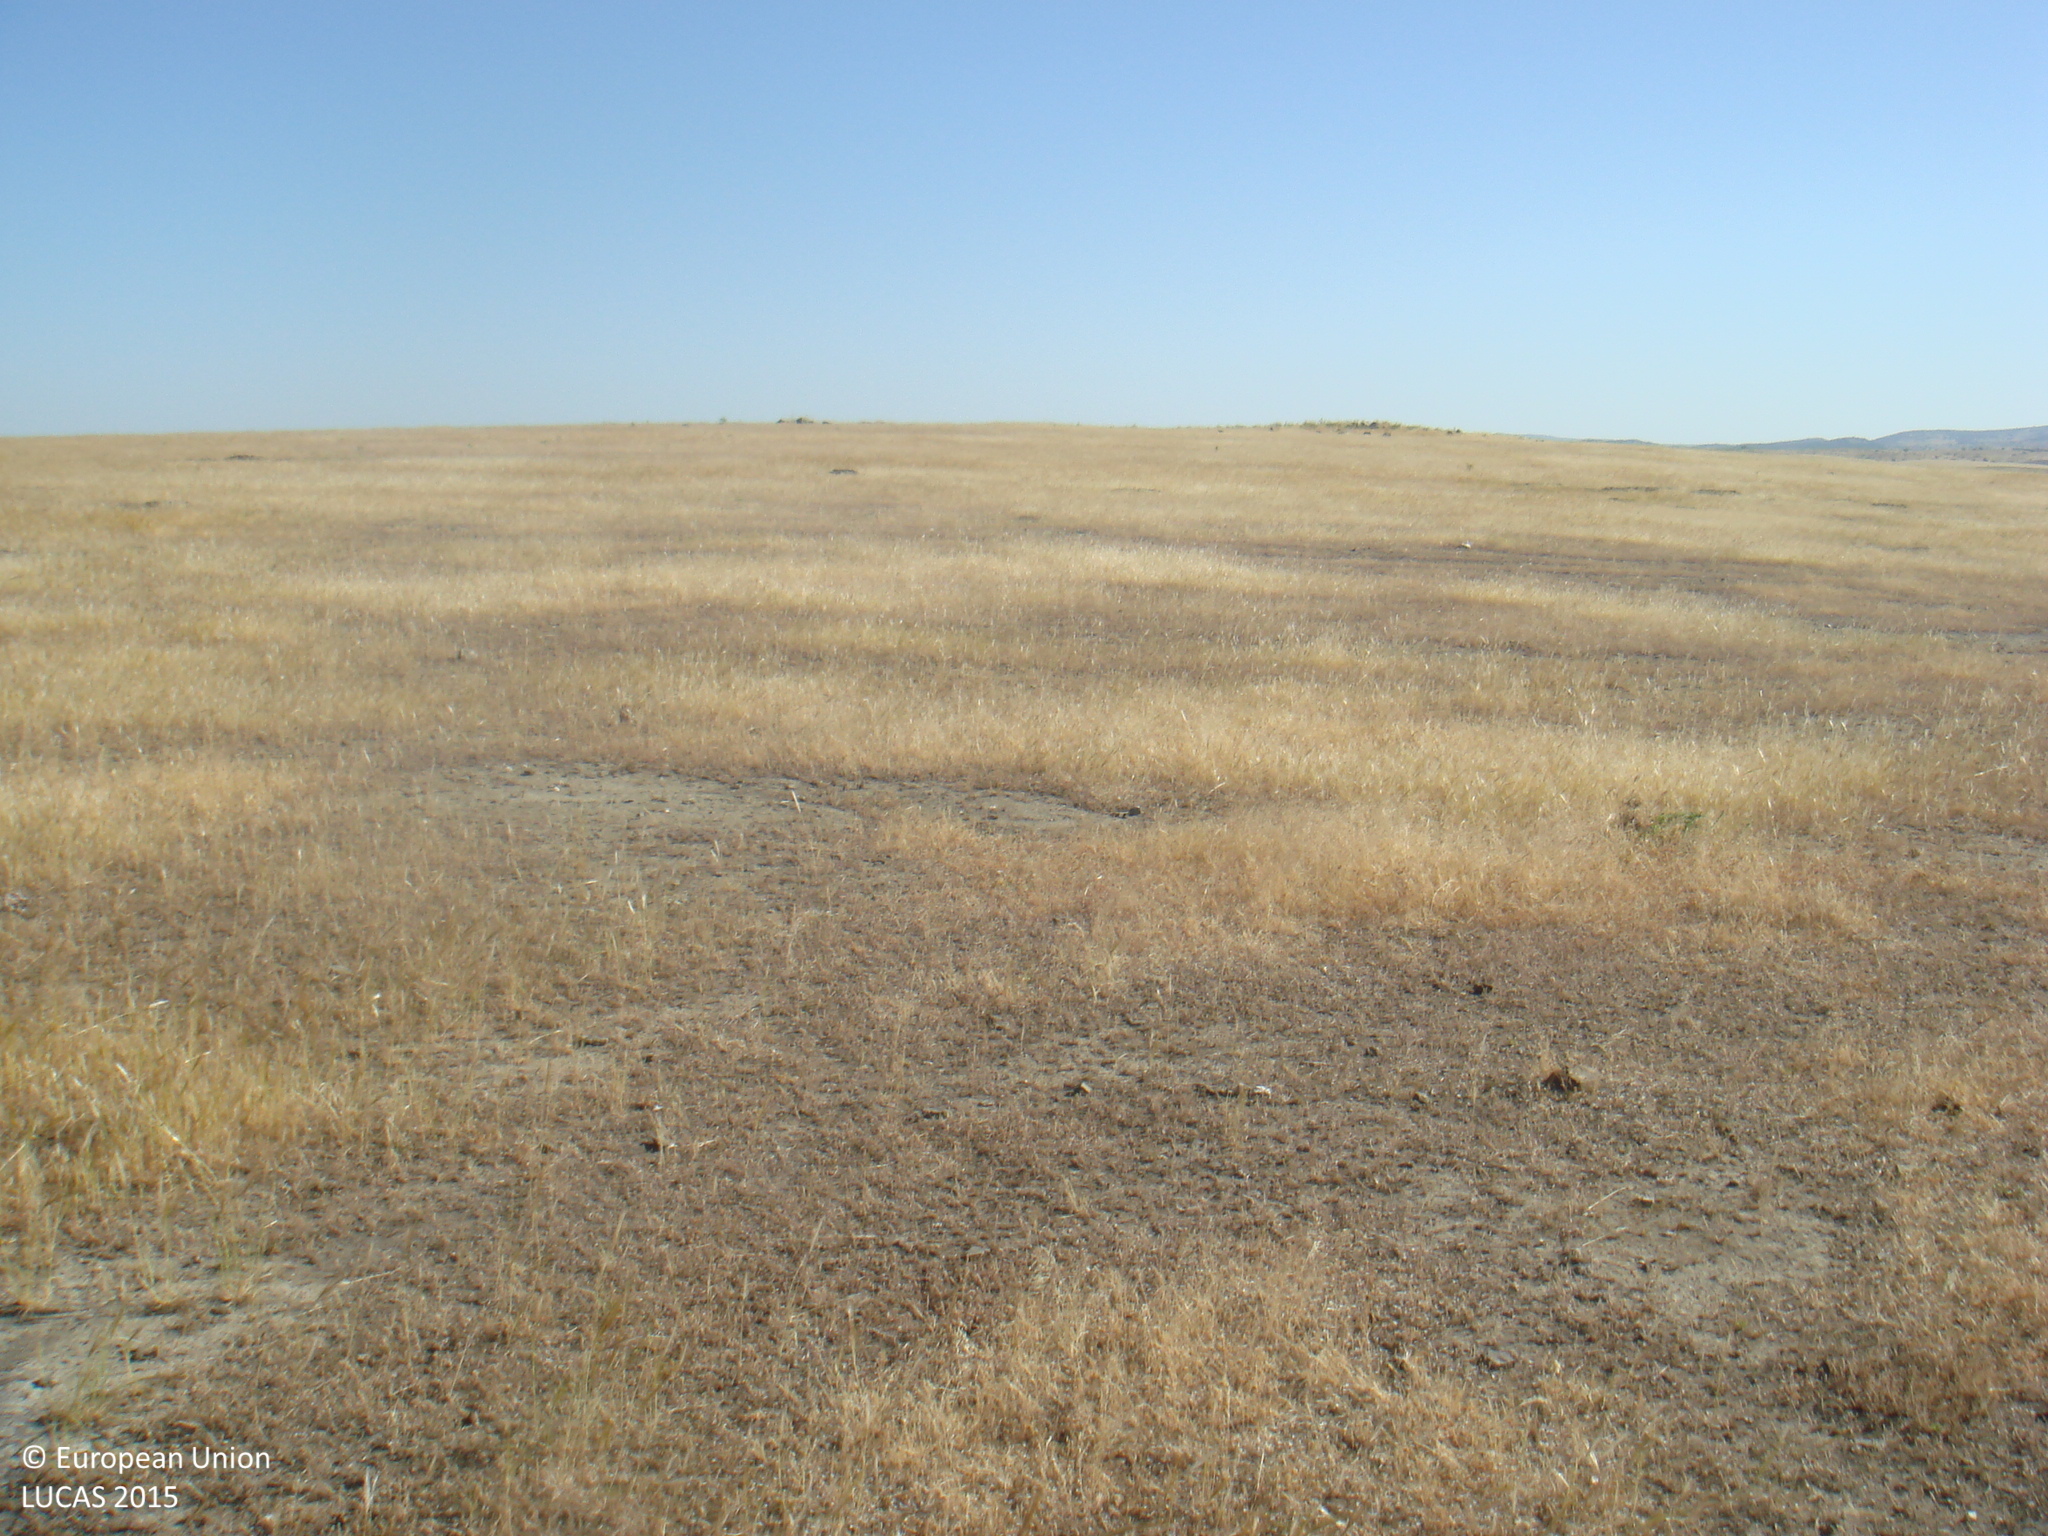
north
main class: Grassland
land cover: Spontaneously vegetated surfaces
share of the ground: > 75 %
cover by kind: herbaceous plants 100 %
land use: Agriculture (excluding fallow land and kitchen gardens)
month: May
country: ES
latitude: 38.5975
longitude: -5.0832
